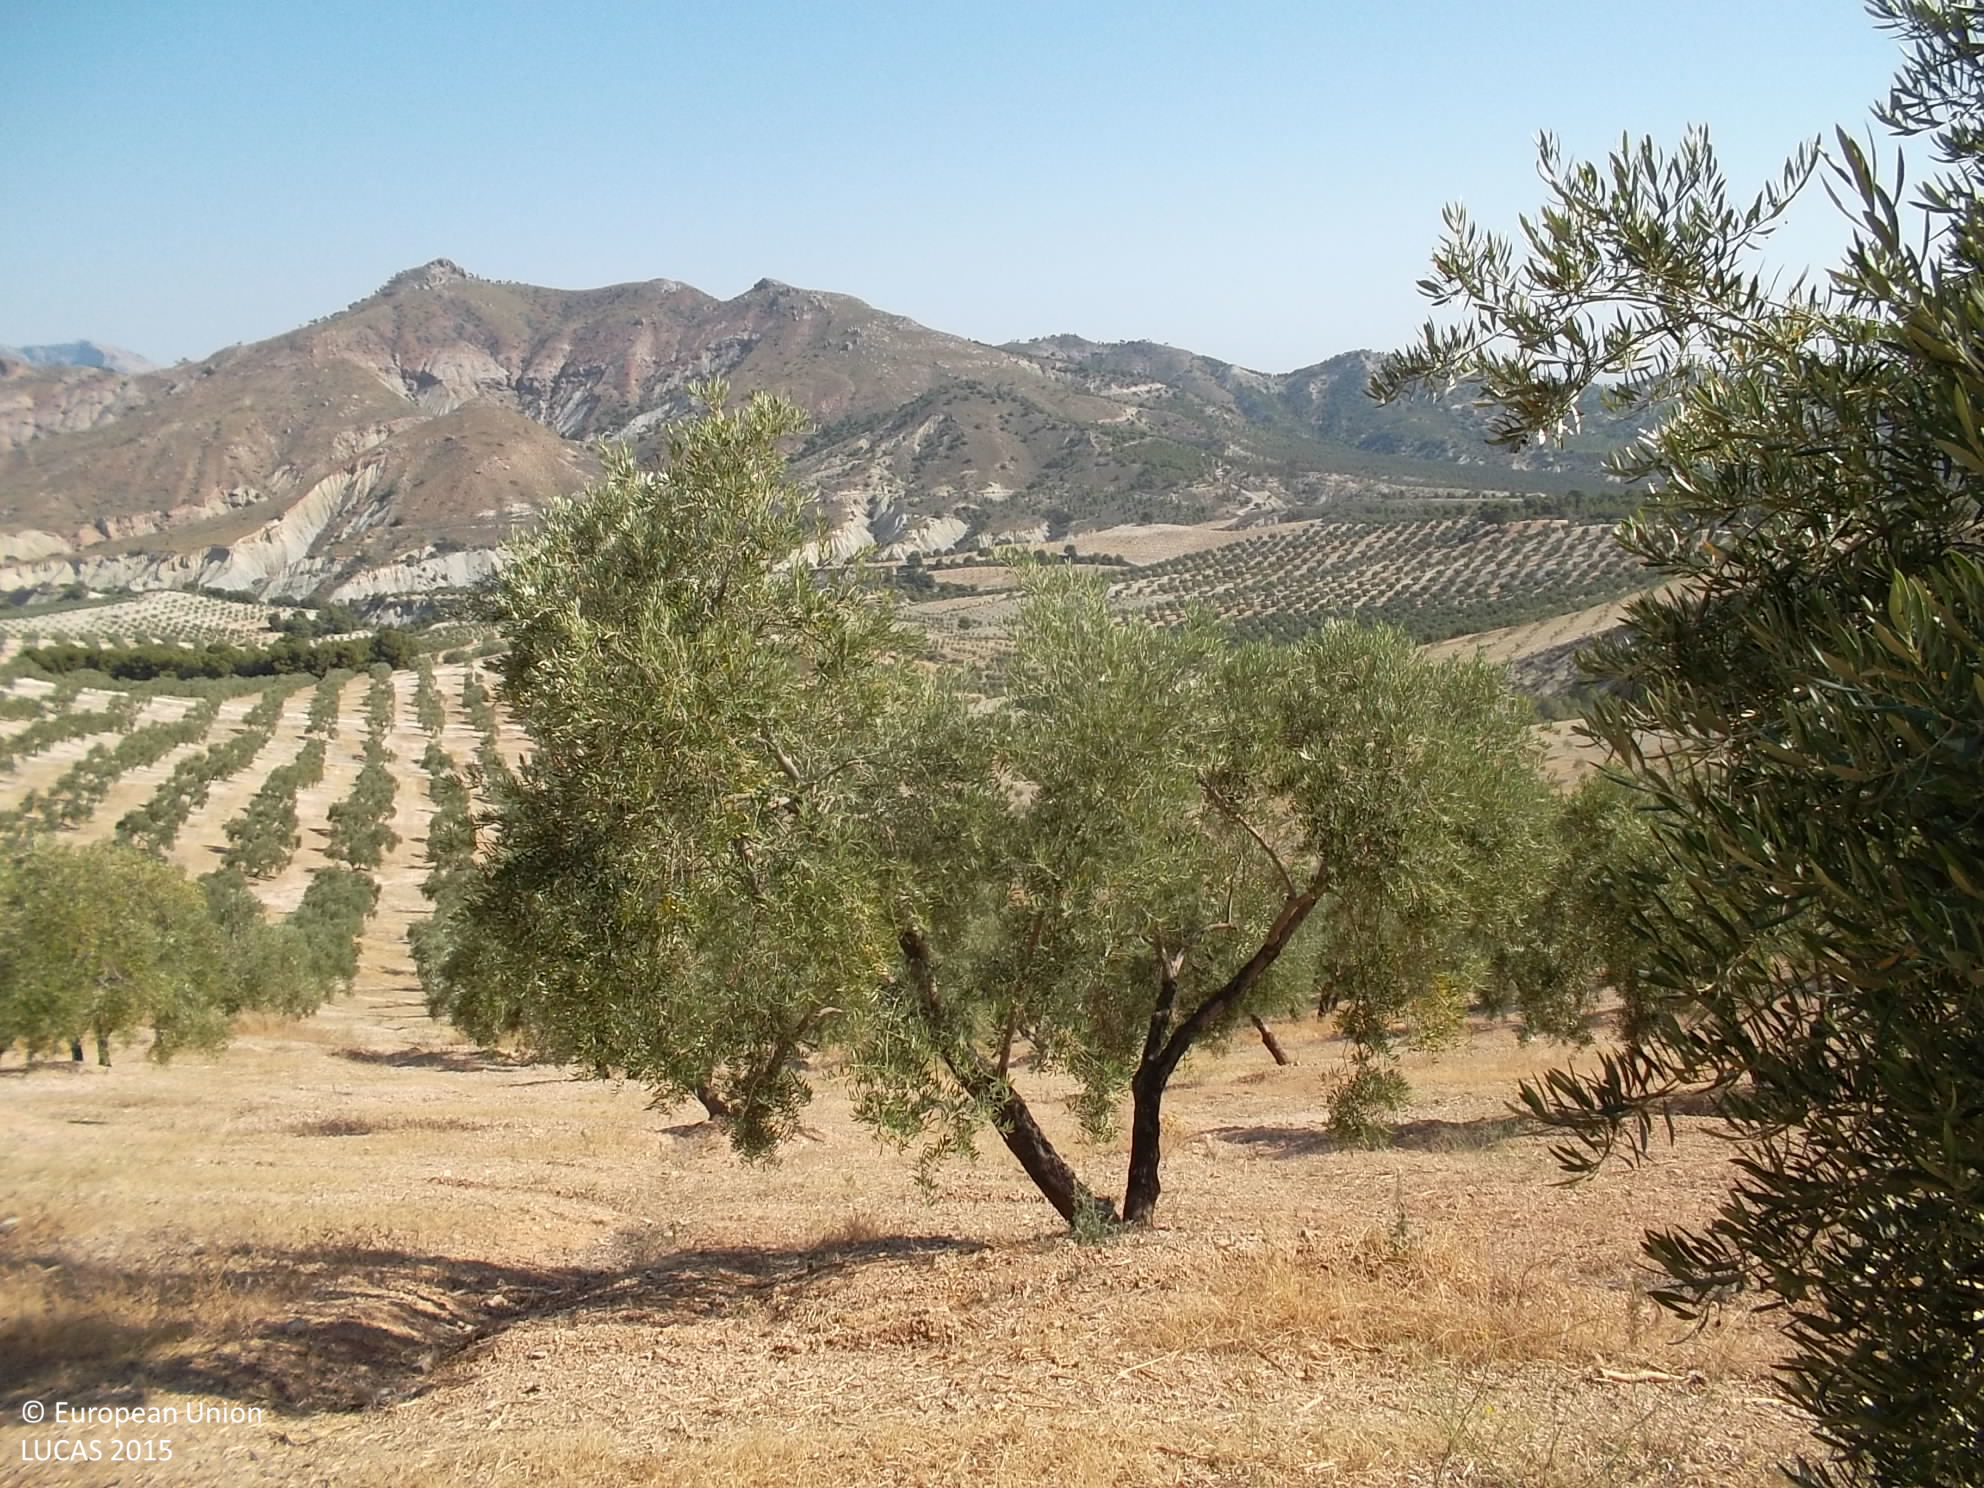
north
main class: Cropland
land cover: Olive groves
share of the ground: 25 - 50 %
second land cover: Spontaneously vegetated surfaces
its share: > 75 %
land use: Agriculture (excluding fallow land and kitchen gardens)
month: June
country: ES
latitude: 37.7257
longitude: -3.3037
